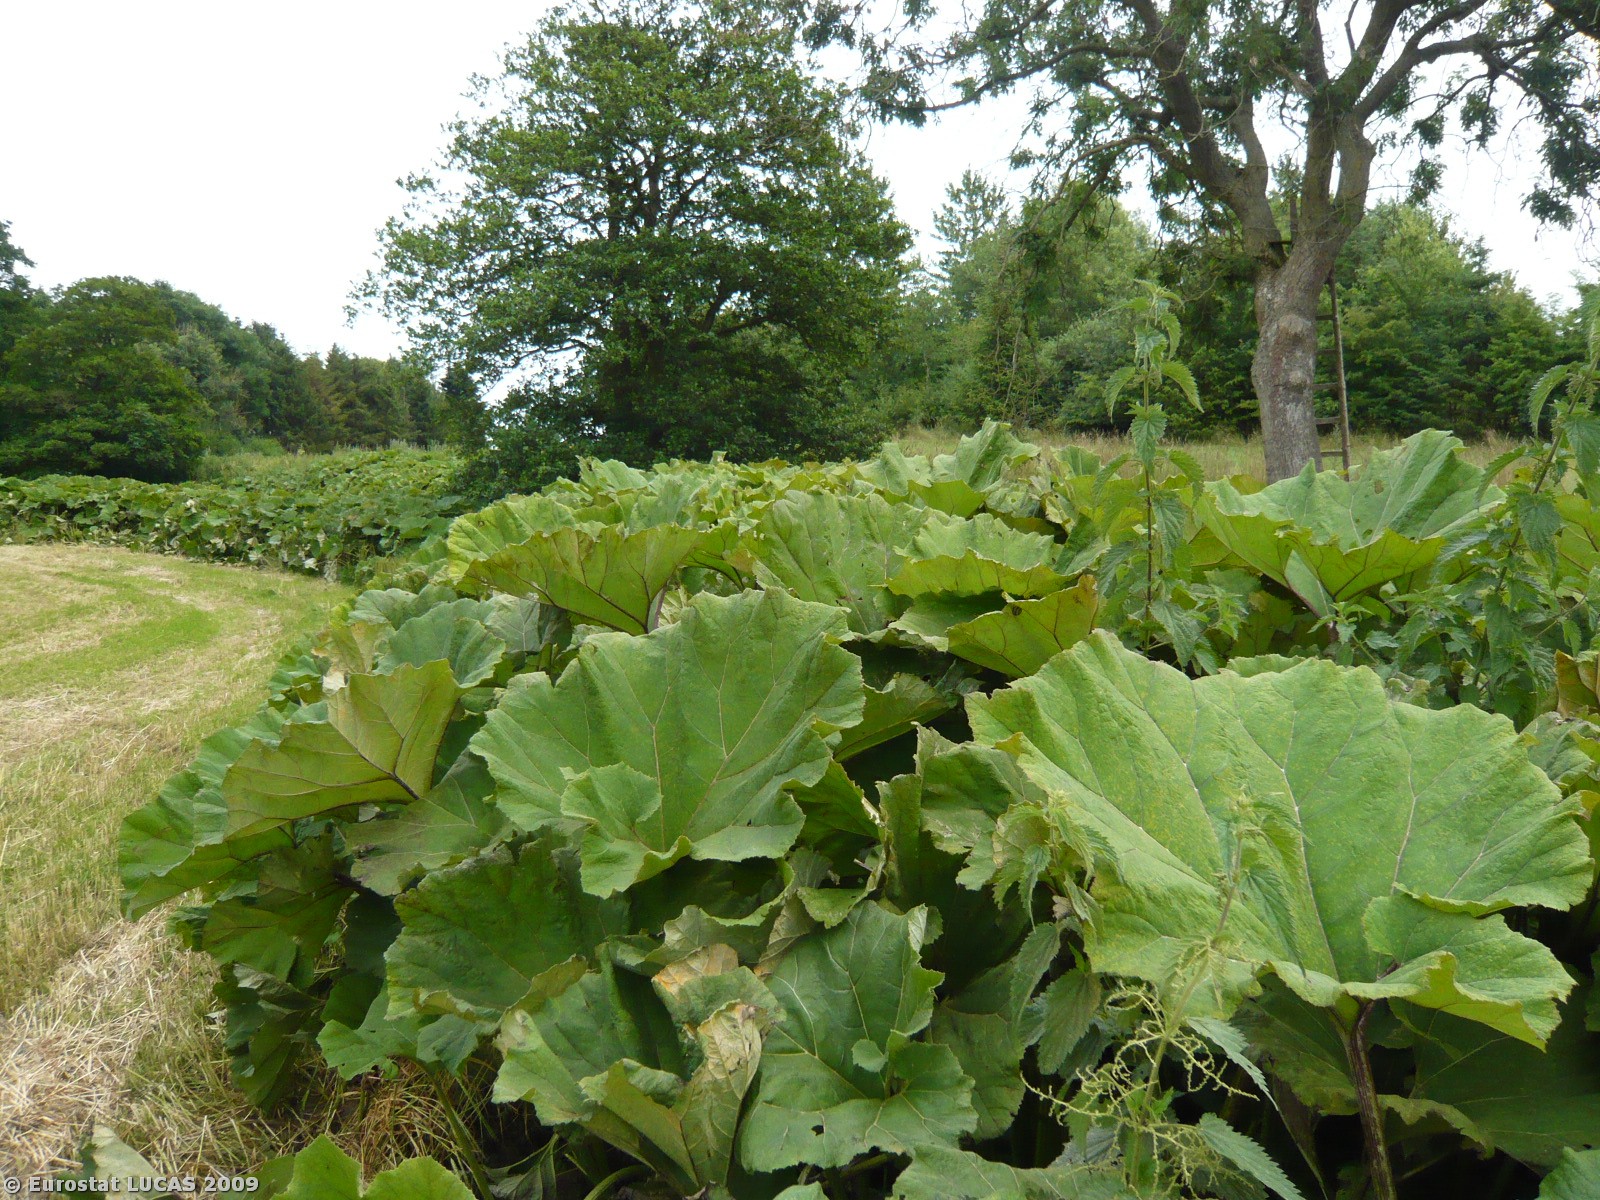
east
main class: Grassland
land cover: Grassland without tree/shrub cover
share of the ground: > 75 %
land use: Agriculture (excluding fallow land and kitchen gardens)
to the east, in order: Grassland without tree/shrub cover; Broadleaved woodland; Arable land (only in case pi); Broadleaved woodland; Coniferous woodland; Arable land (only in case pi); Coniferous woodland; Broadleaved woodland
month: July
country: DK
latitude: 55.5285
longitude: 11.7570
